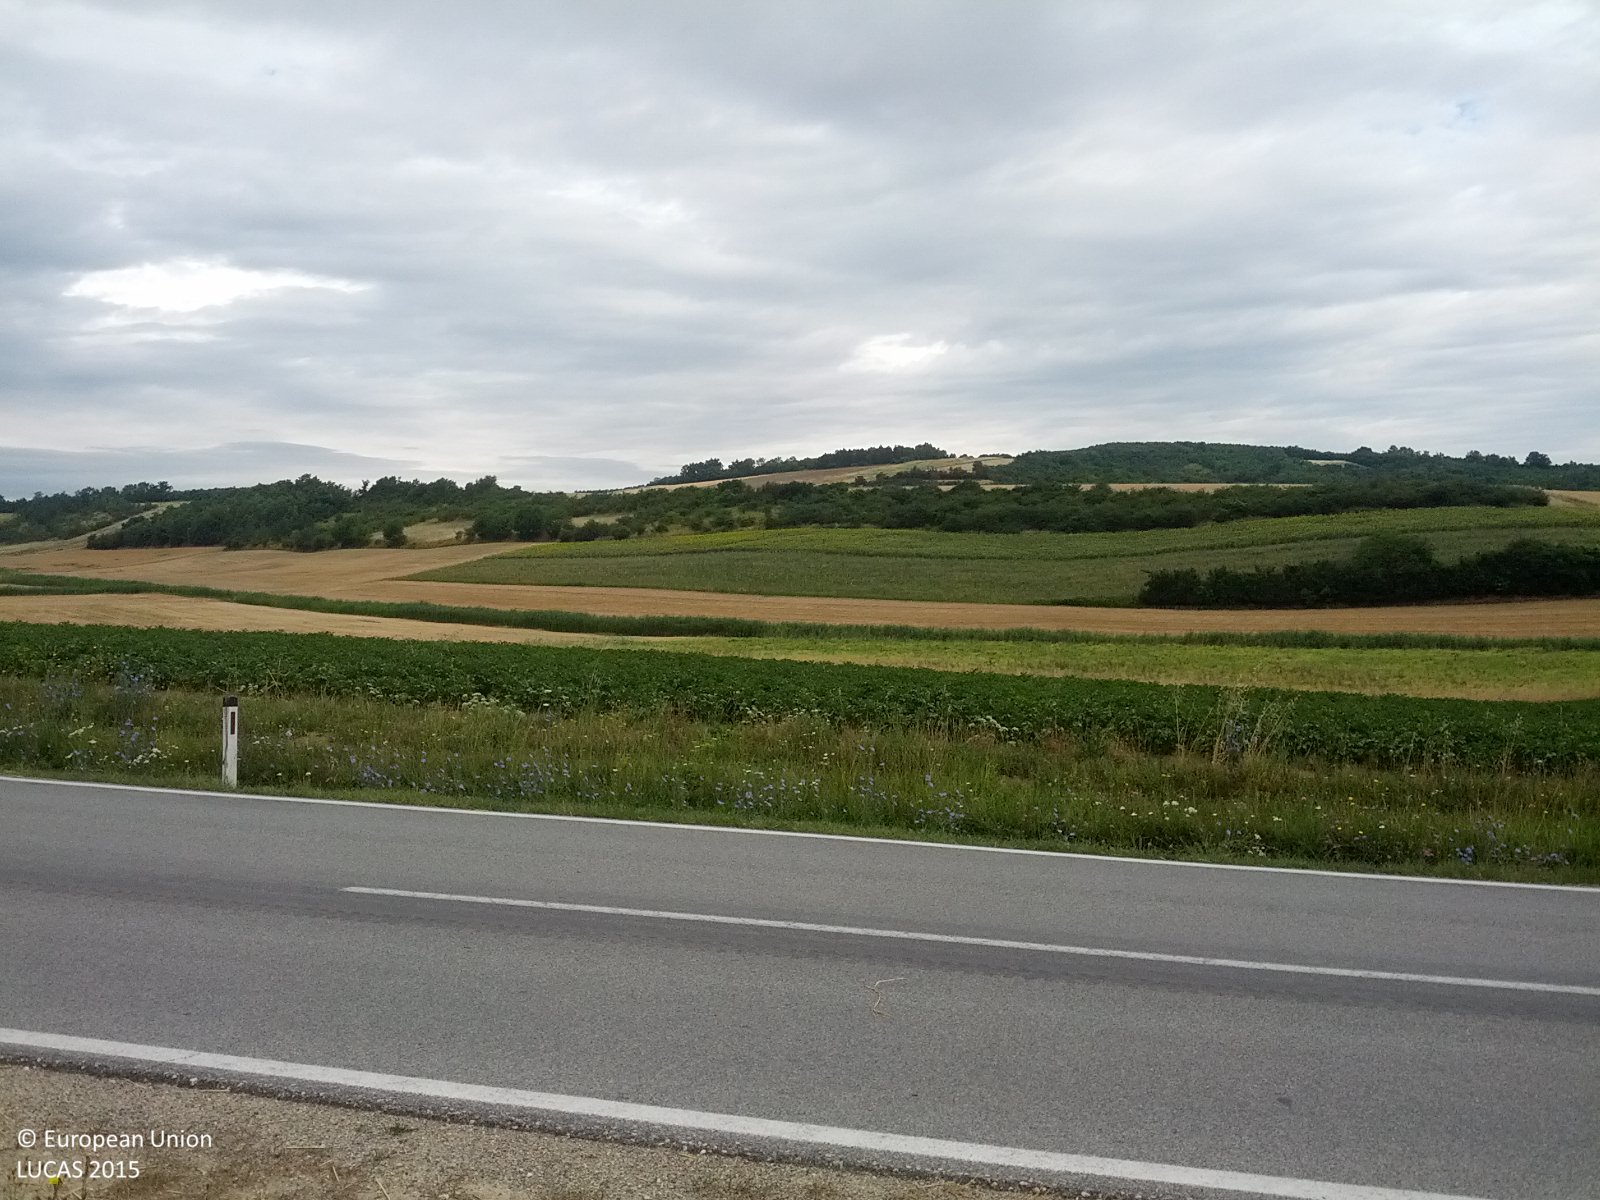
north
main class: Cropland
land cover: Common wheat
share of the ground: 10 - 25 %
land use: Agriculture (excluding fallow land and kitchen gardens)
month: July
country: AT
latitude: 48.6185
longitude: 16.3406
